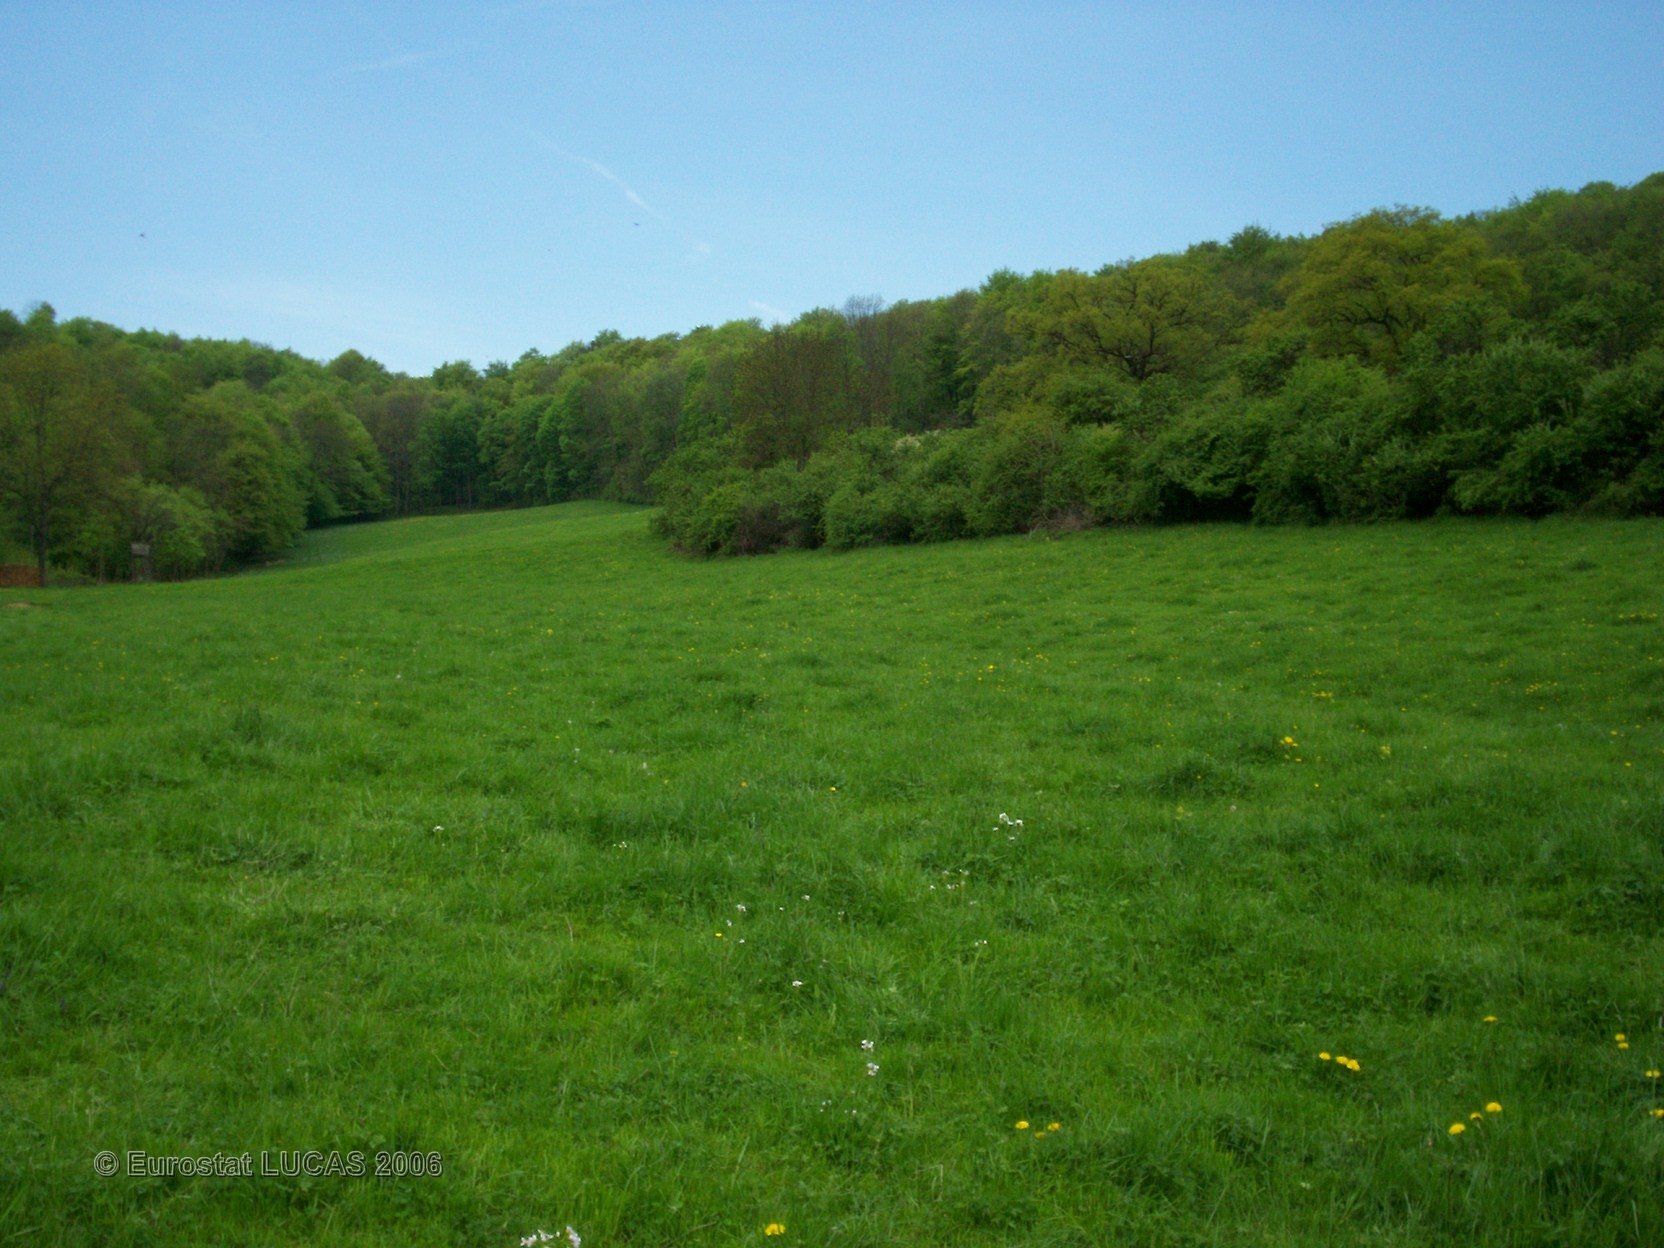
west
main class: Grassland
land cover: Grassland without tree/shrub cover
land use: Agriculture (excluding fallow land and kitchen gardens)
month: May
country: FR
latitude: 48.4387
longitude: 5.9854
